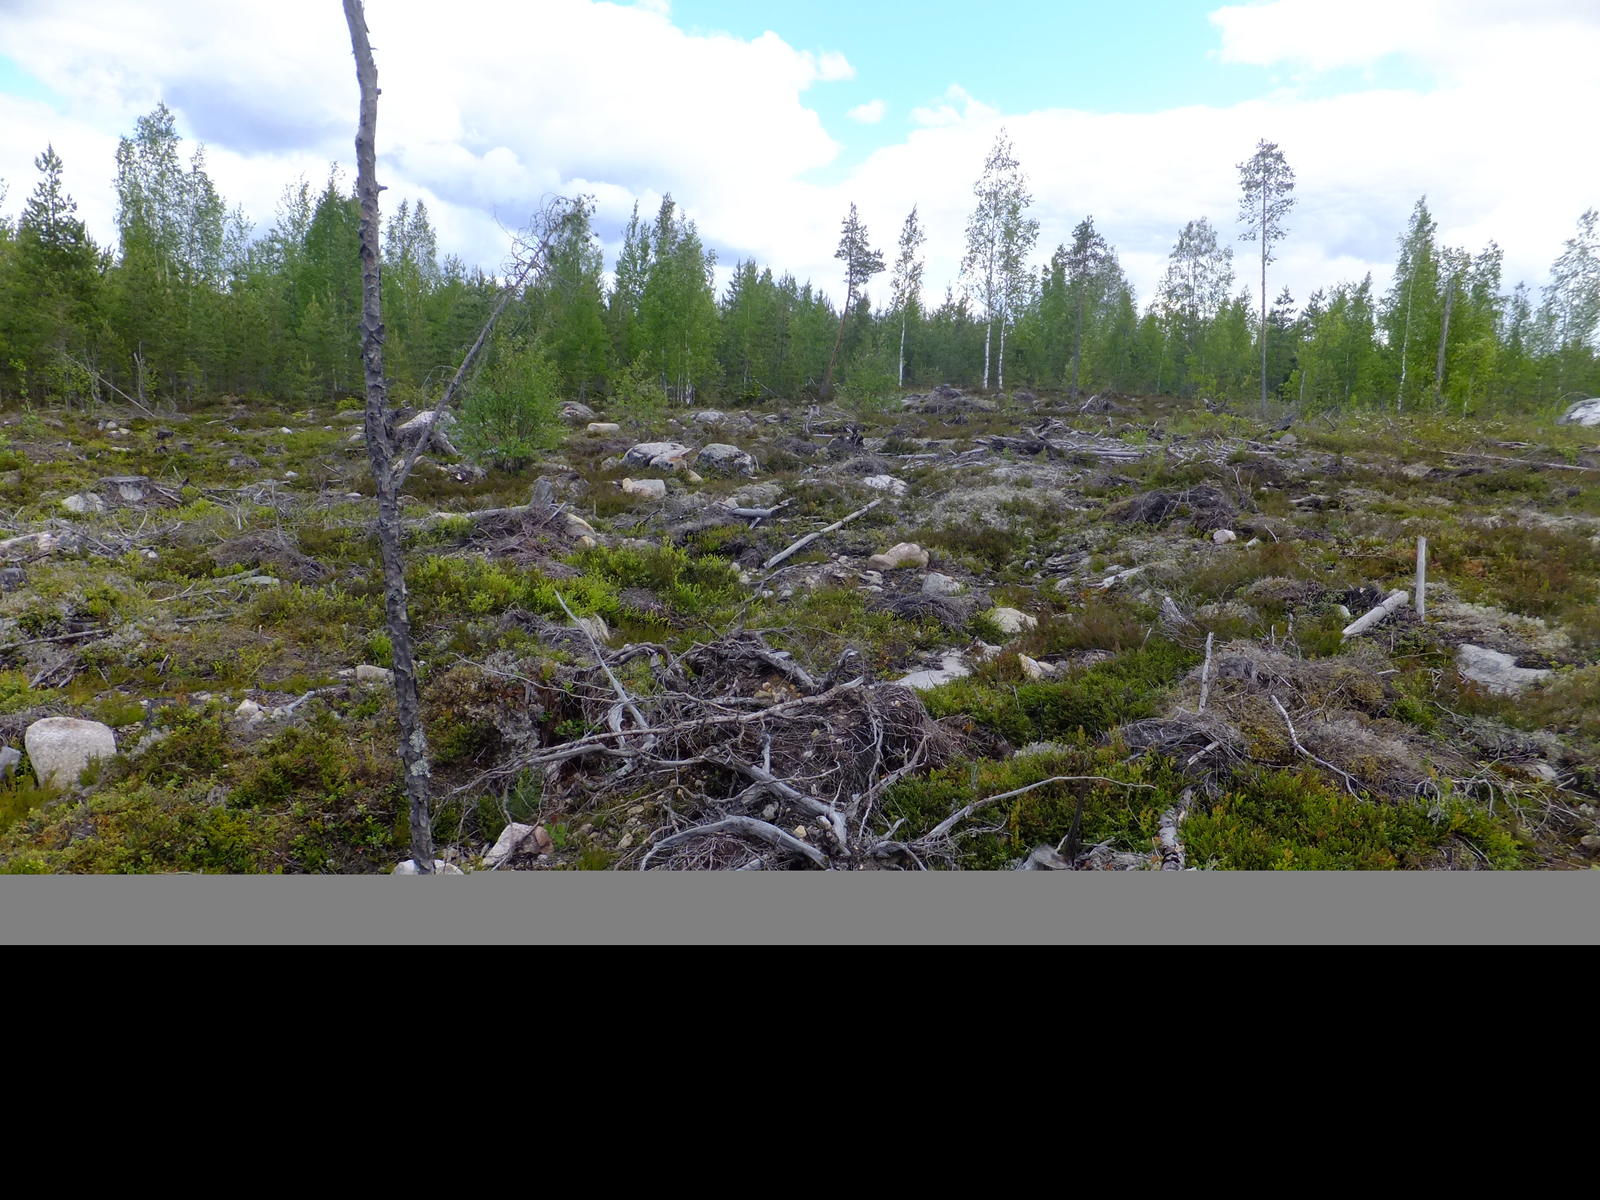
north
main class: Shrubland
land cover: Shrubland with sparse tree cover
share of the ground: 50 - 75 %
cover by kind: shrubs 55 %, lichens and mosses 20 %, consolidated bare surface 20 %, broadleaved forest trees 5 %
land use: Forestry
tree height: > 5 m
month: June
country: FI
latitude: 63.4876
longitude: 24.8863
